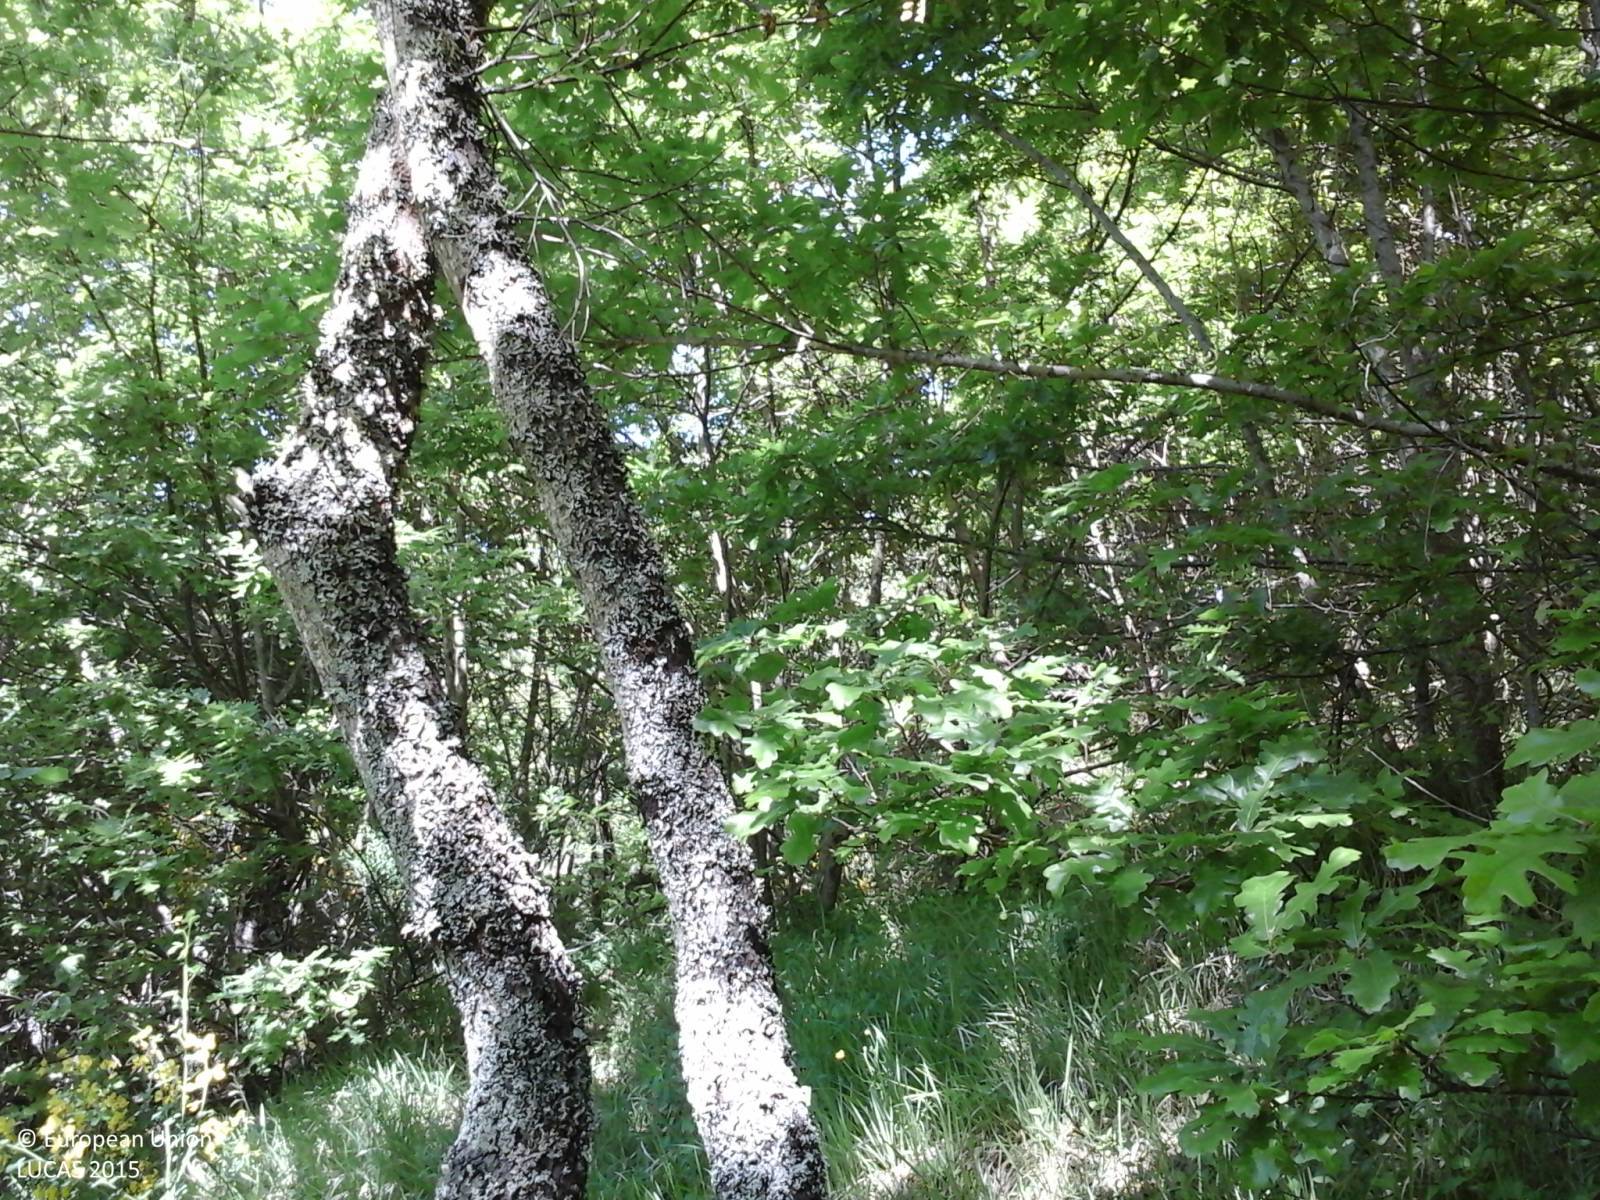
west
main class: Woodland
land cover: Broadleaved woodland
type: thermophilous deciduous forest
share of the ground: > 75 %
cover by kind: broadleaved forest trees 90 %, shrubs 5 %, herbaceous plants 5 %
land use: Forestry
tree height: > 5 m
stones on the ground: < 10 %
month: May
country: IT
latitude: 42.1148
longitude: 13.2182
